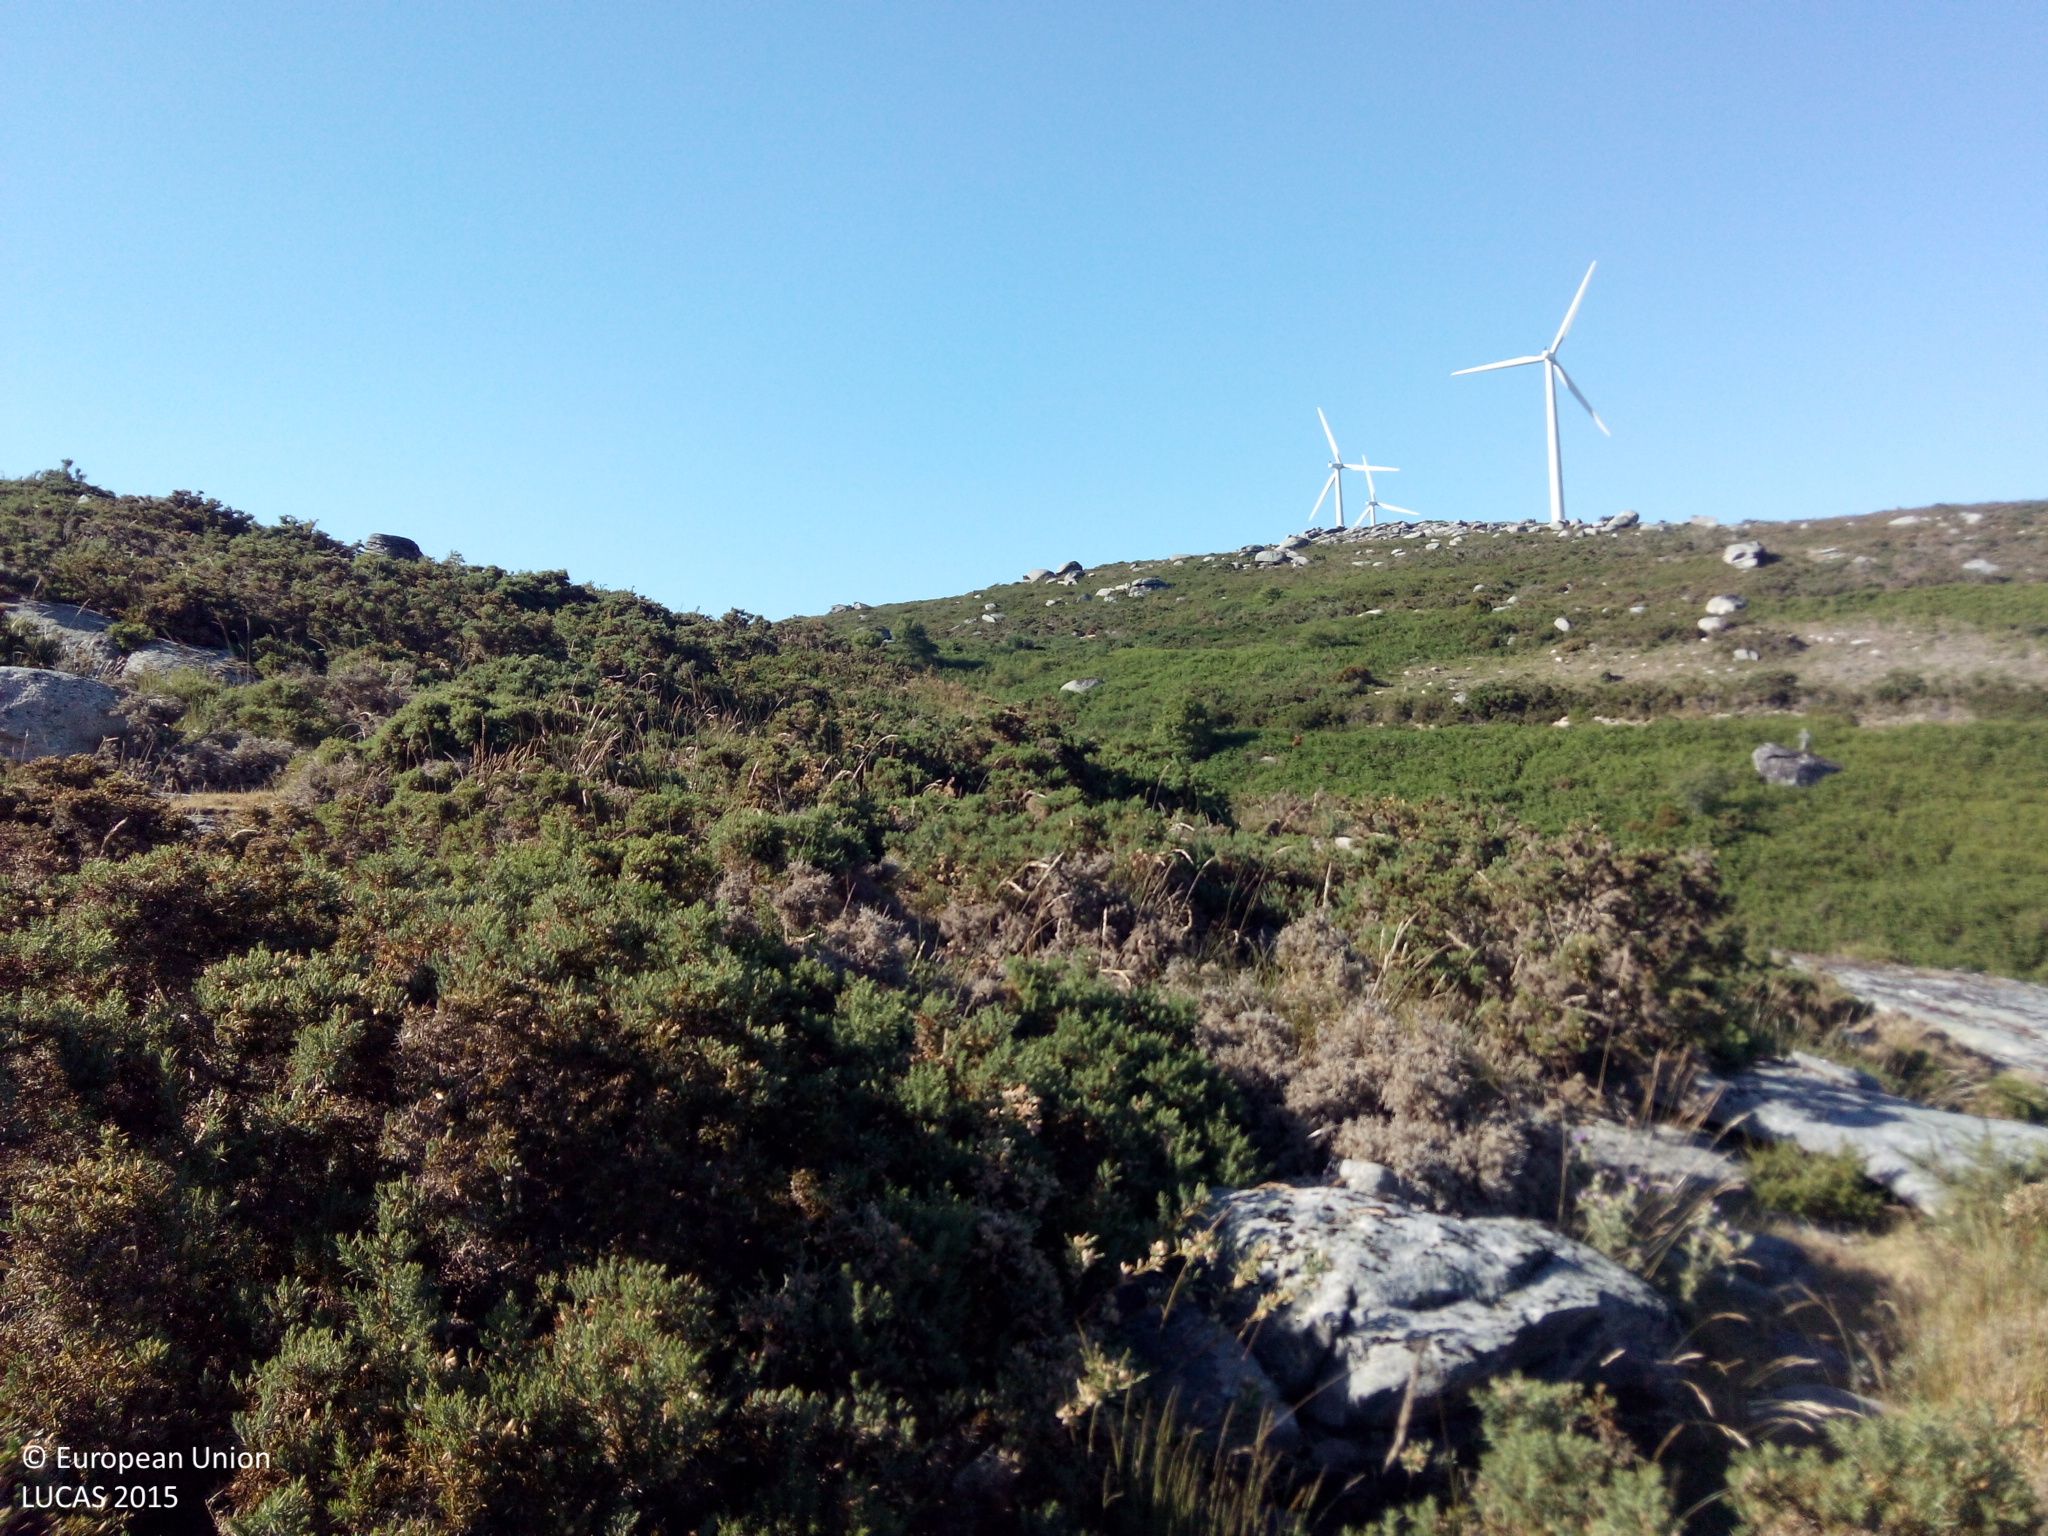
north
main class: Shrubland
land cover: Shrubland without tree cover
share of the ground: > 75 %
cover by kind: shrubs 100 %
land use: Semi-natural and natural areas not in use
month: June
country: ES
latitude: 42.3310
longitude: -8.3309
